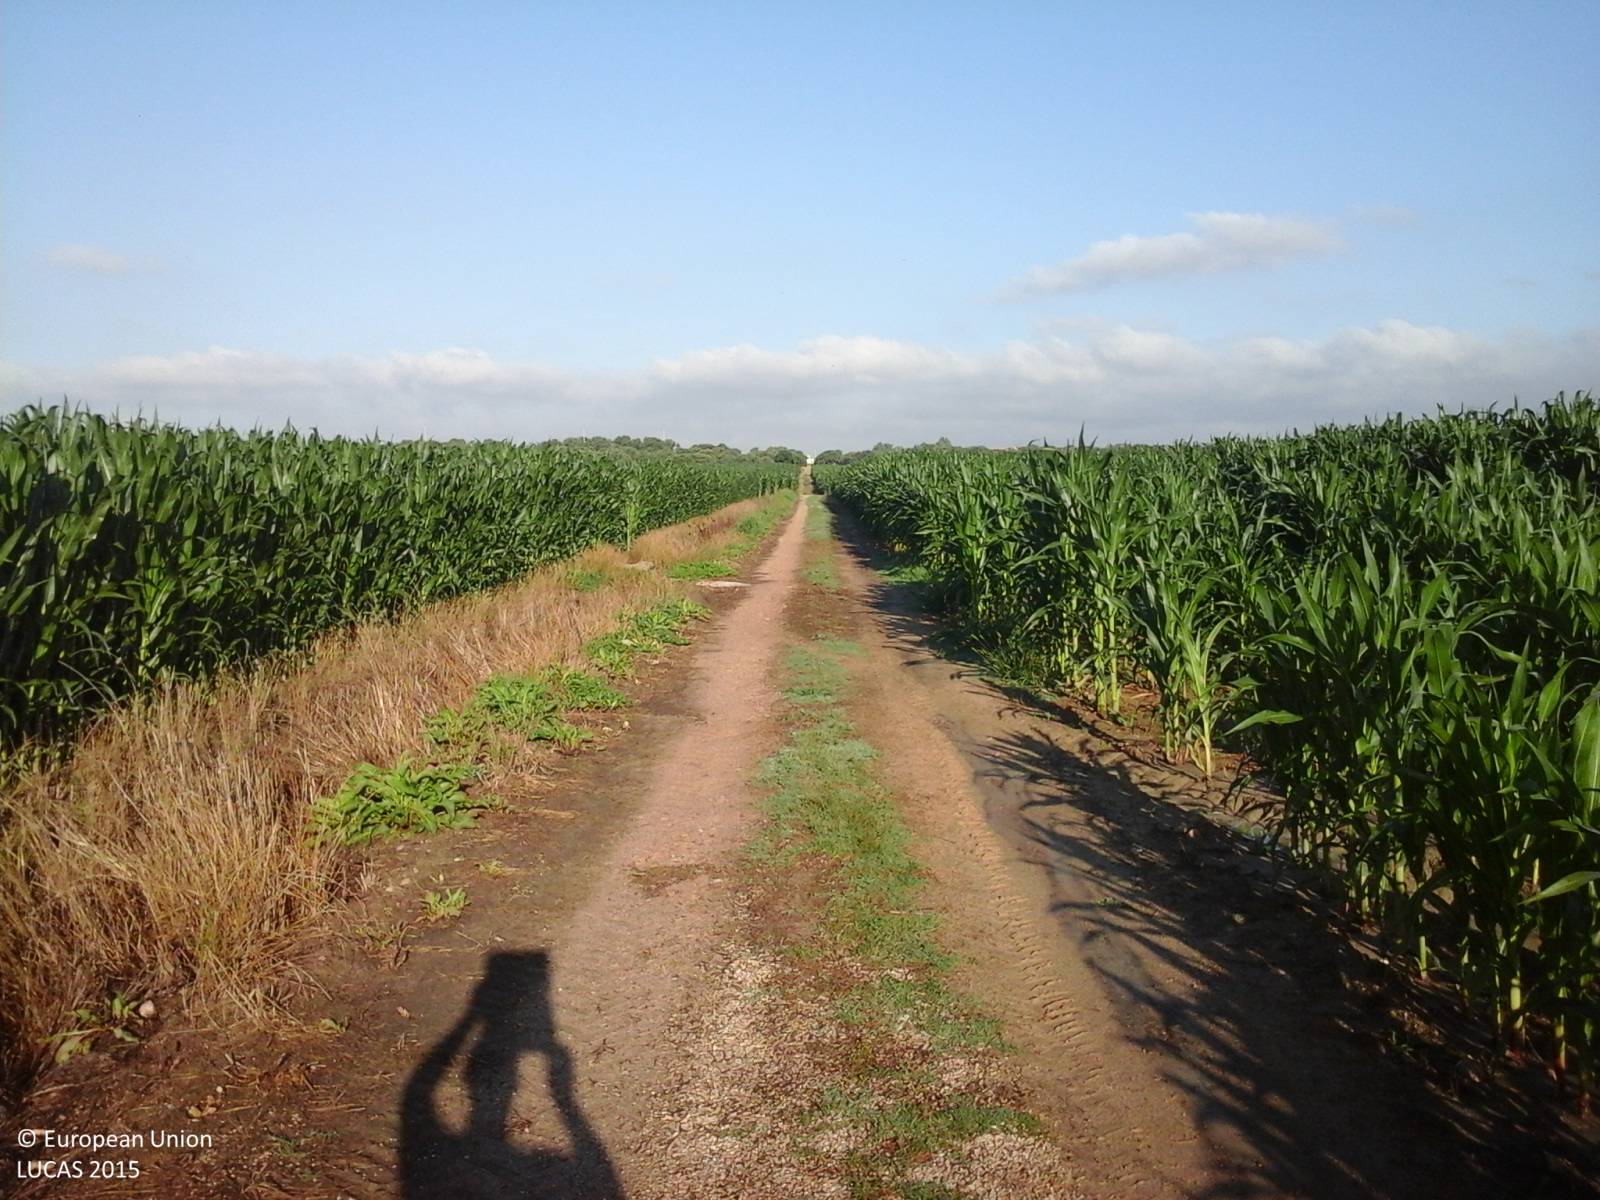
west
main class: Cropland
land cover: Maize
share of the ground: > 75 %
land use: Agriculture (excluding fallow land and kitchen gardens)
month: July
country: IT
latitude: 40.6227
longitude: 8.8590
